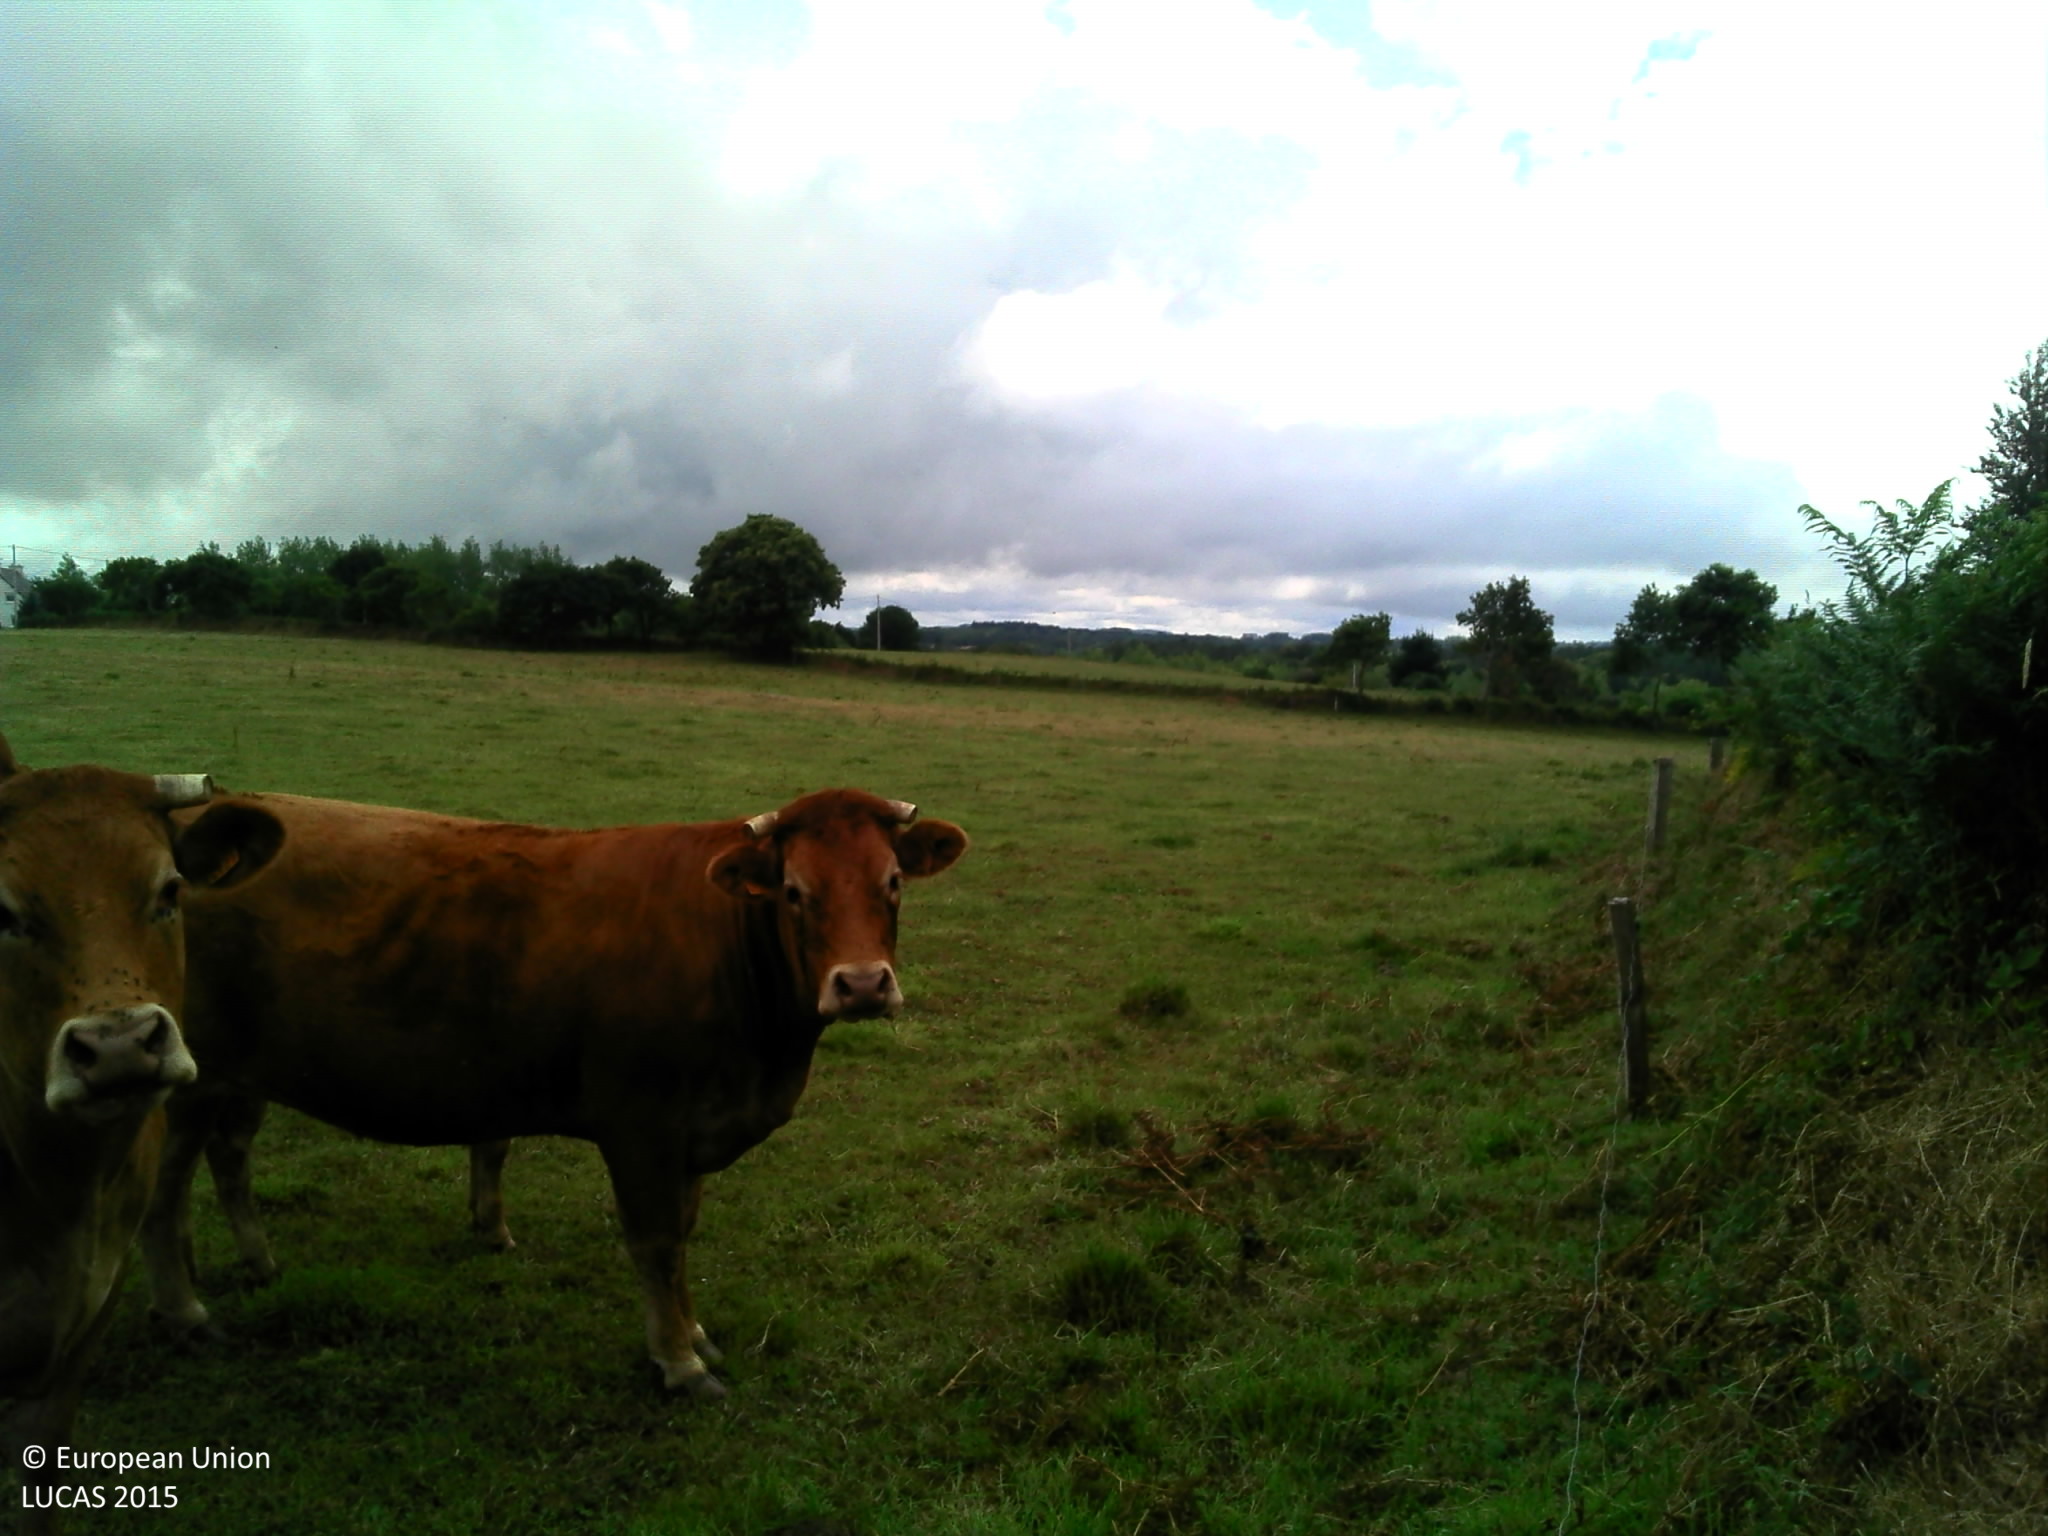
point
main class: Grassland
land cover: Grassland without tree/shrub cover
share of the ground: > 75 %
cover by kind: herbaceous plants 85 %, unconsolidated bare surface 15 %
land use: Agriculture (excluding fallow land and kitchen gardens)
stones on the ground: < 10 %
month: July
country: FR
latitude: 48.6114
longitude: -3.4935
